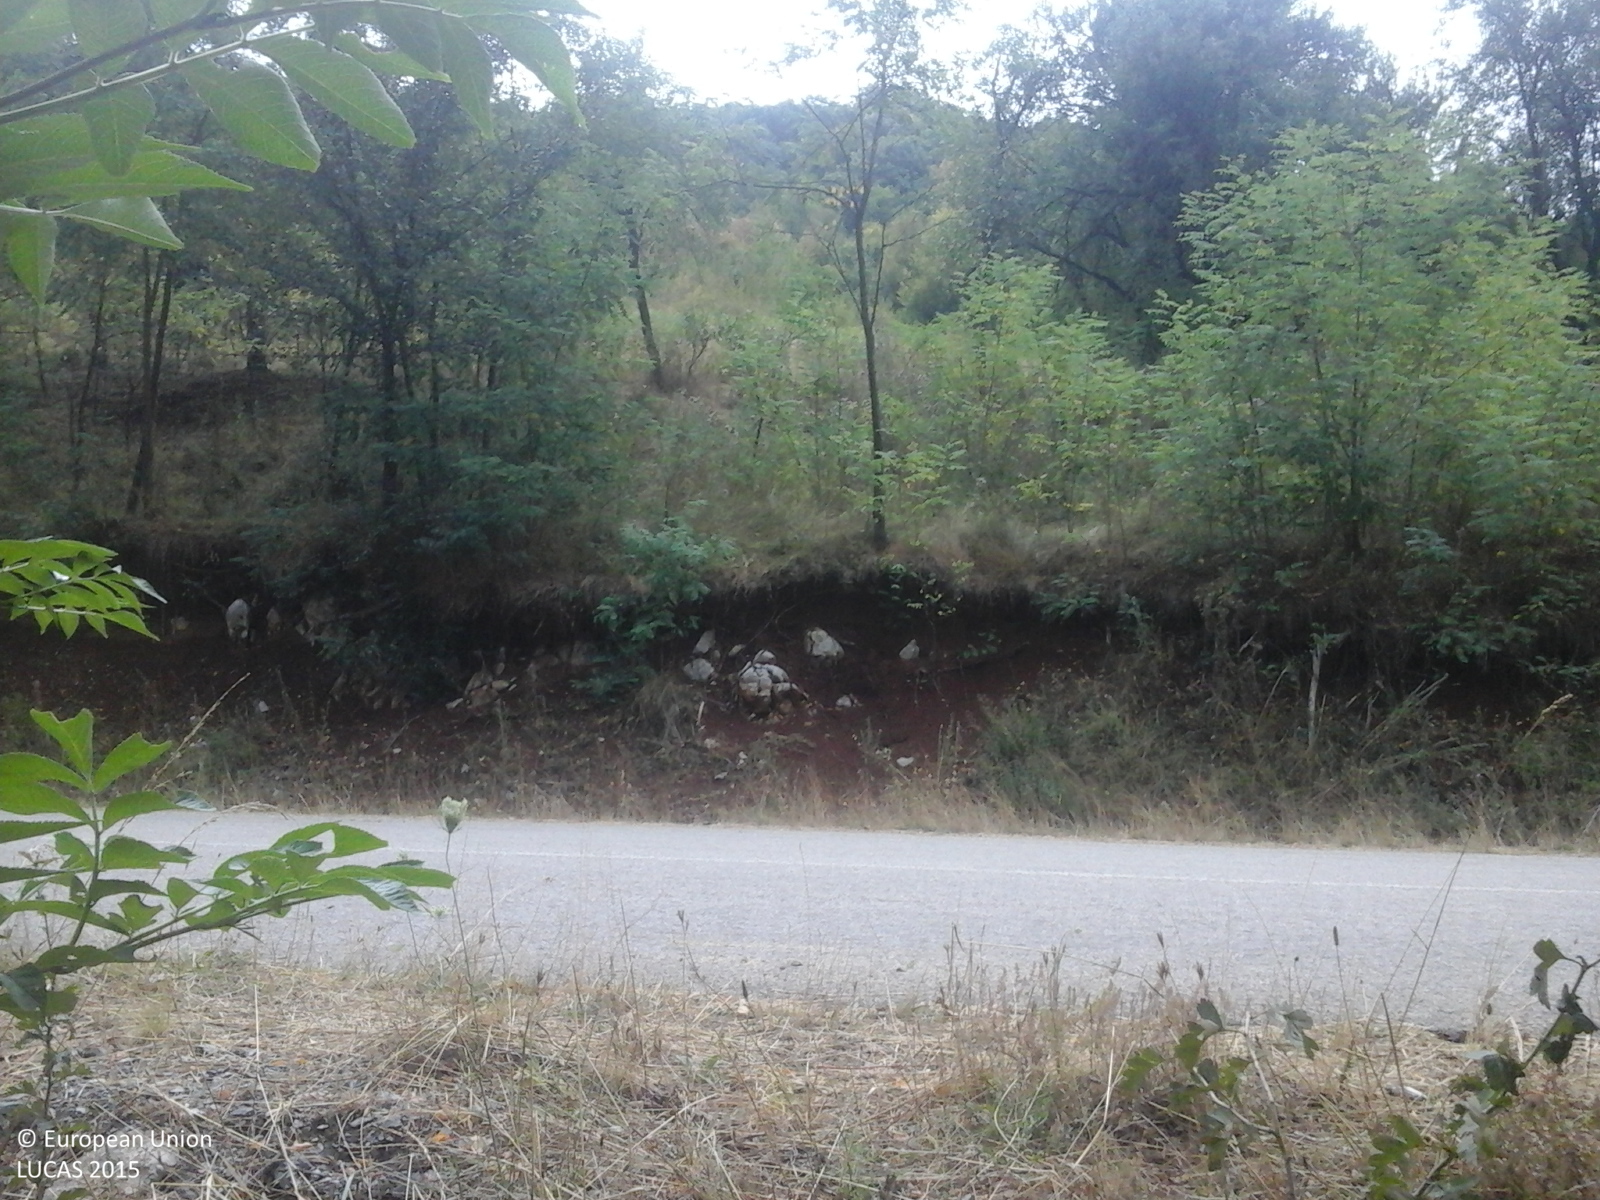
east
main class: Woodland
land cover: Broadleaved woodland
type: thermophilous deciduous forest
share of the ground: > 75 %
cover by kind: broadleaved forest trees 80 %, shrubs 10 %, herbaceous plants 10 %
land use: Forestry
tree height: > 5 m
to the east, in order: Broadleaved woodland; Paved roads, cycling and walking lanes; Ditches and canals; Broadleaved woodland
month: August
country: RO
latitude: 44.9549
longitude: 22.6821
